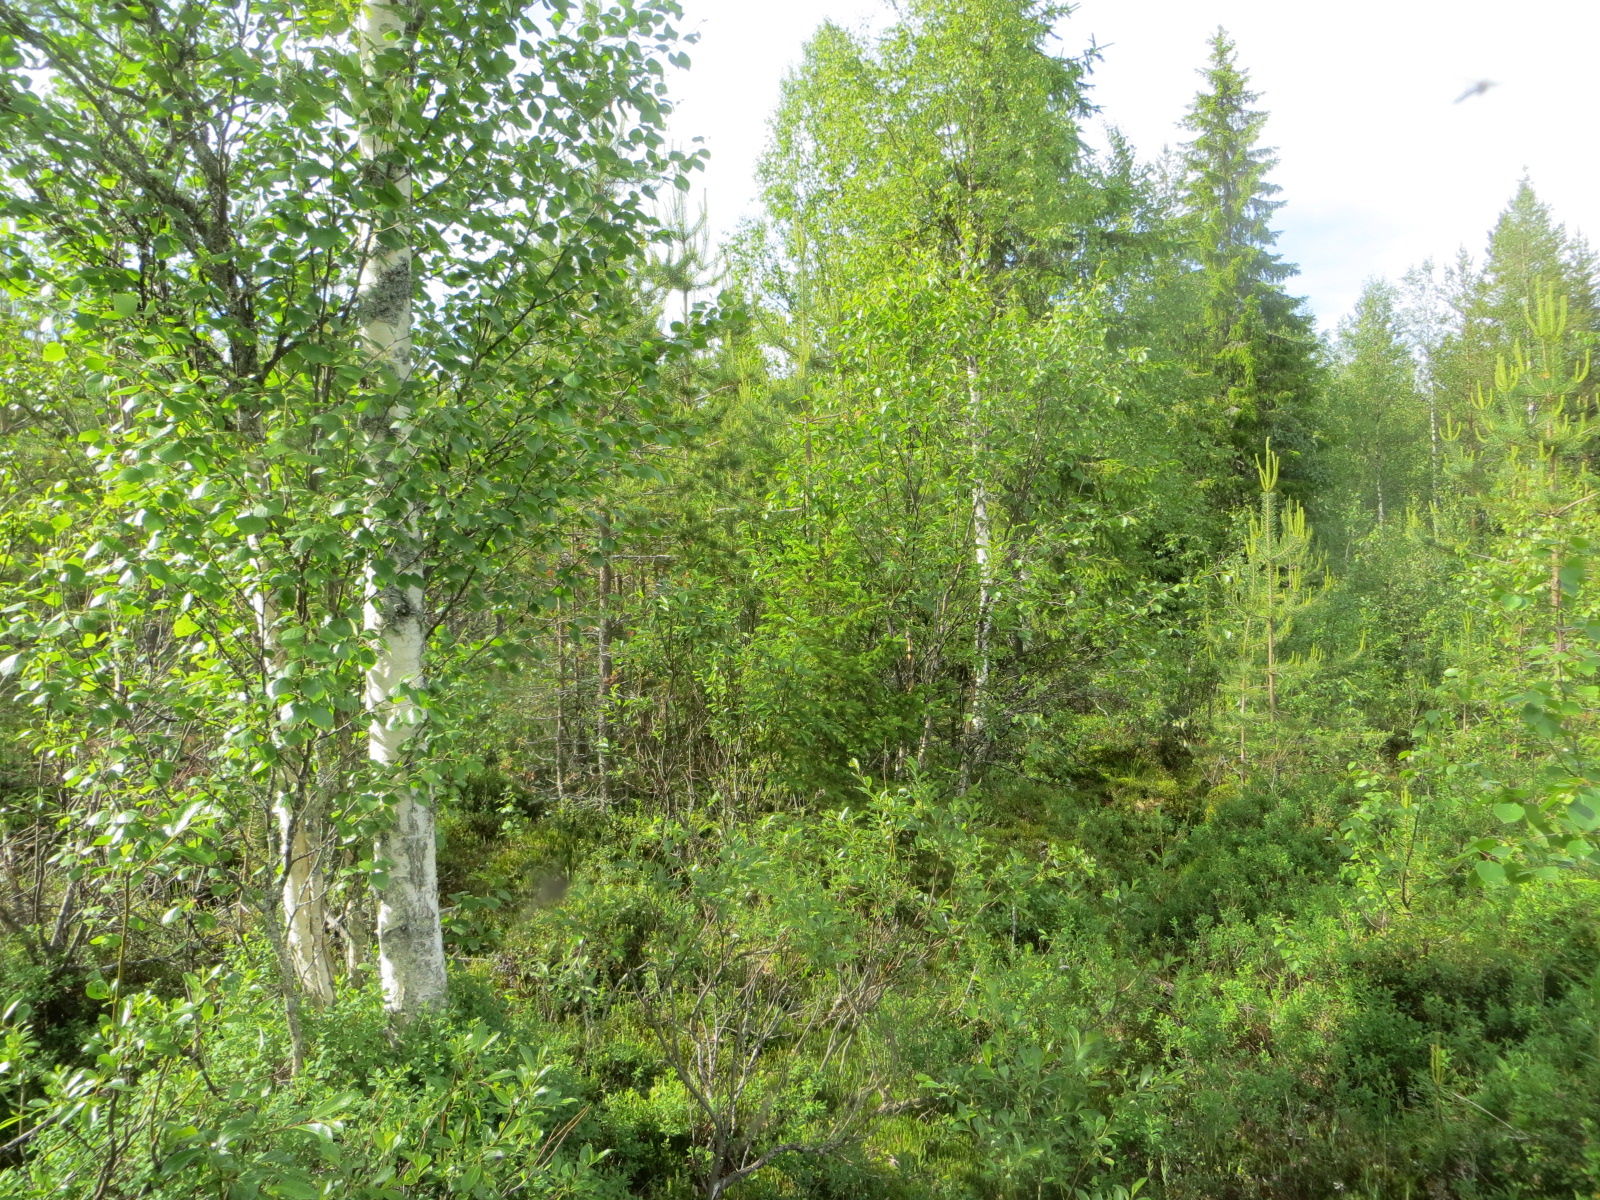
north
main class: Woodland
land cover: Broadleaved woodland
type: hemiboreal forest and nemoral coniferous forest and mixed broadleaved-coniferous forest
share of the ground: > 75 %
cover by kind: broadleaved forest trees 85 %, coniferous forest trees 10 %, shrubs 5 %
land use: Forestry
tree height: < 5 m
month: June
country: FI
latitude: 65.5086
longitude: 26.1549
